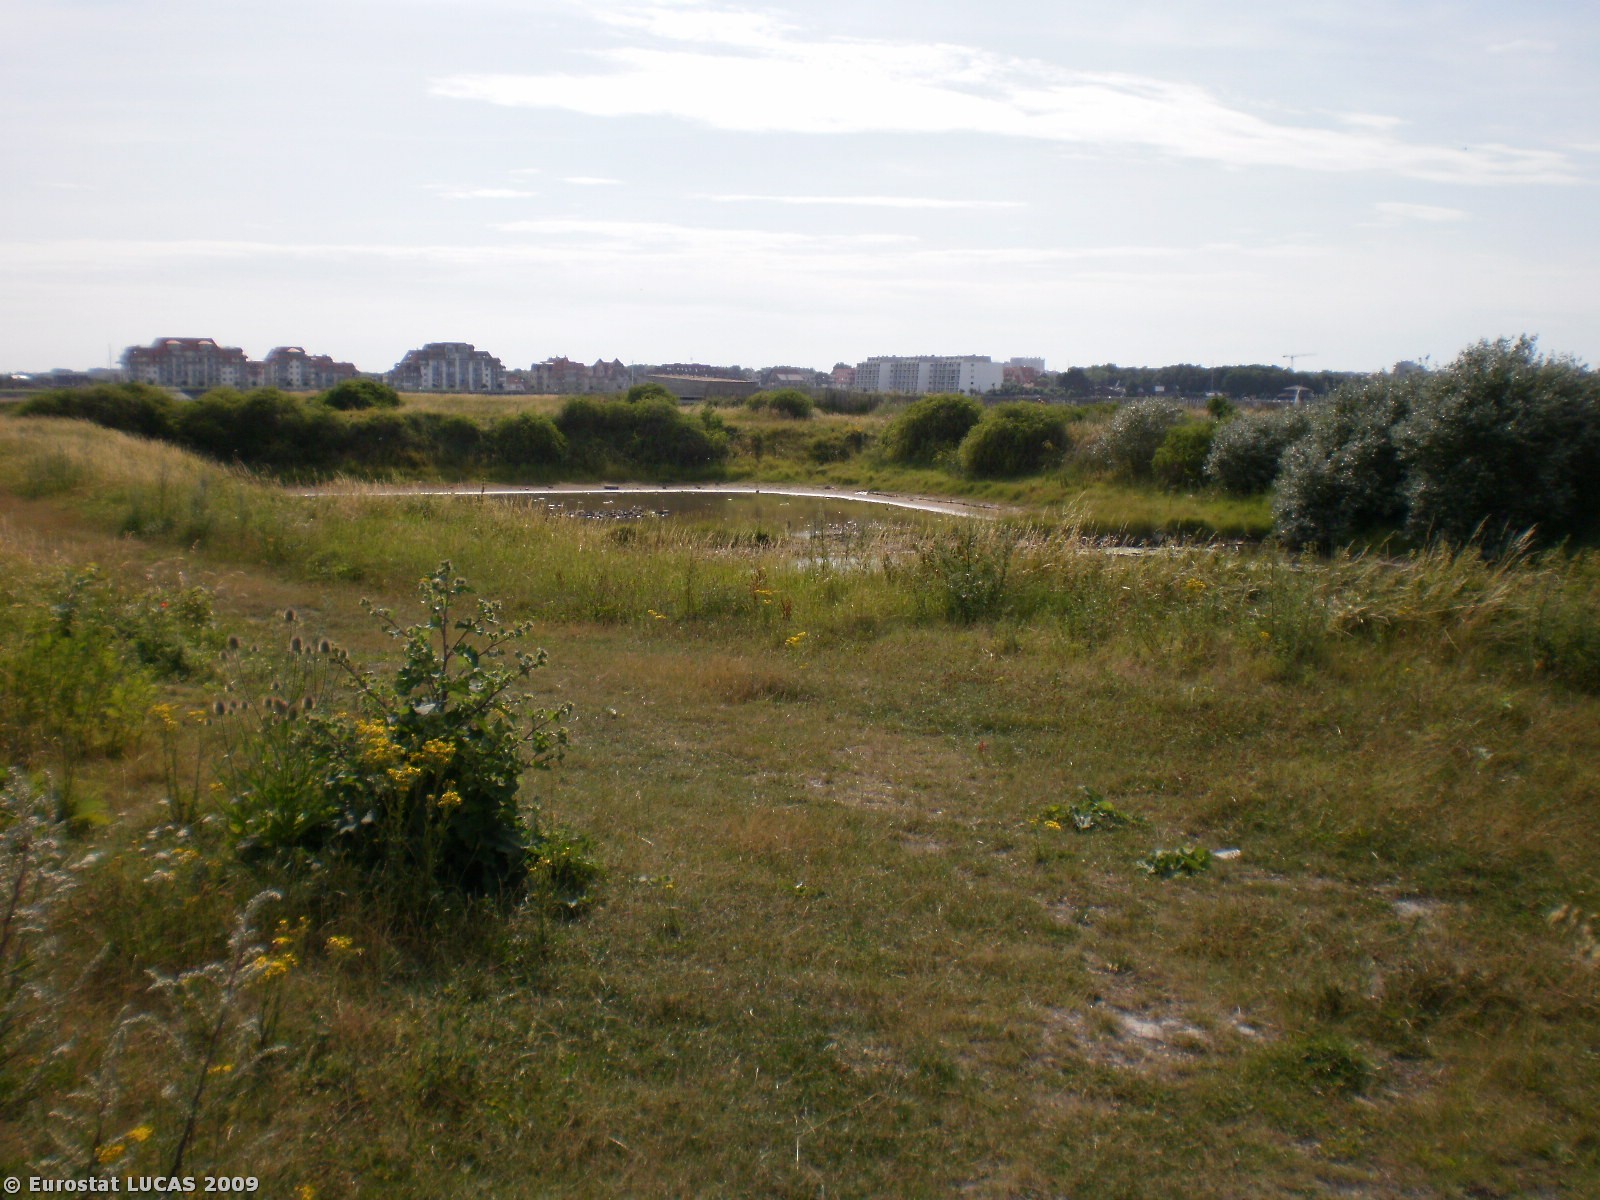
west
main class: Wetlands
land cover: Intertidal flats
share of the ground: > 75 %
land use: Nature reserves
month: July
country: BE
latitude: 51.1443
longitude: 2.7414
